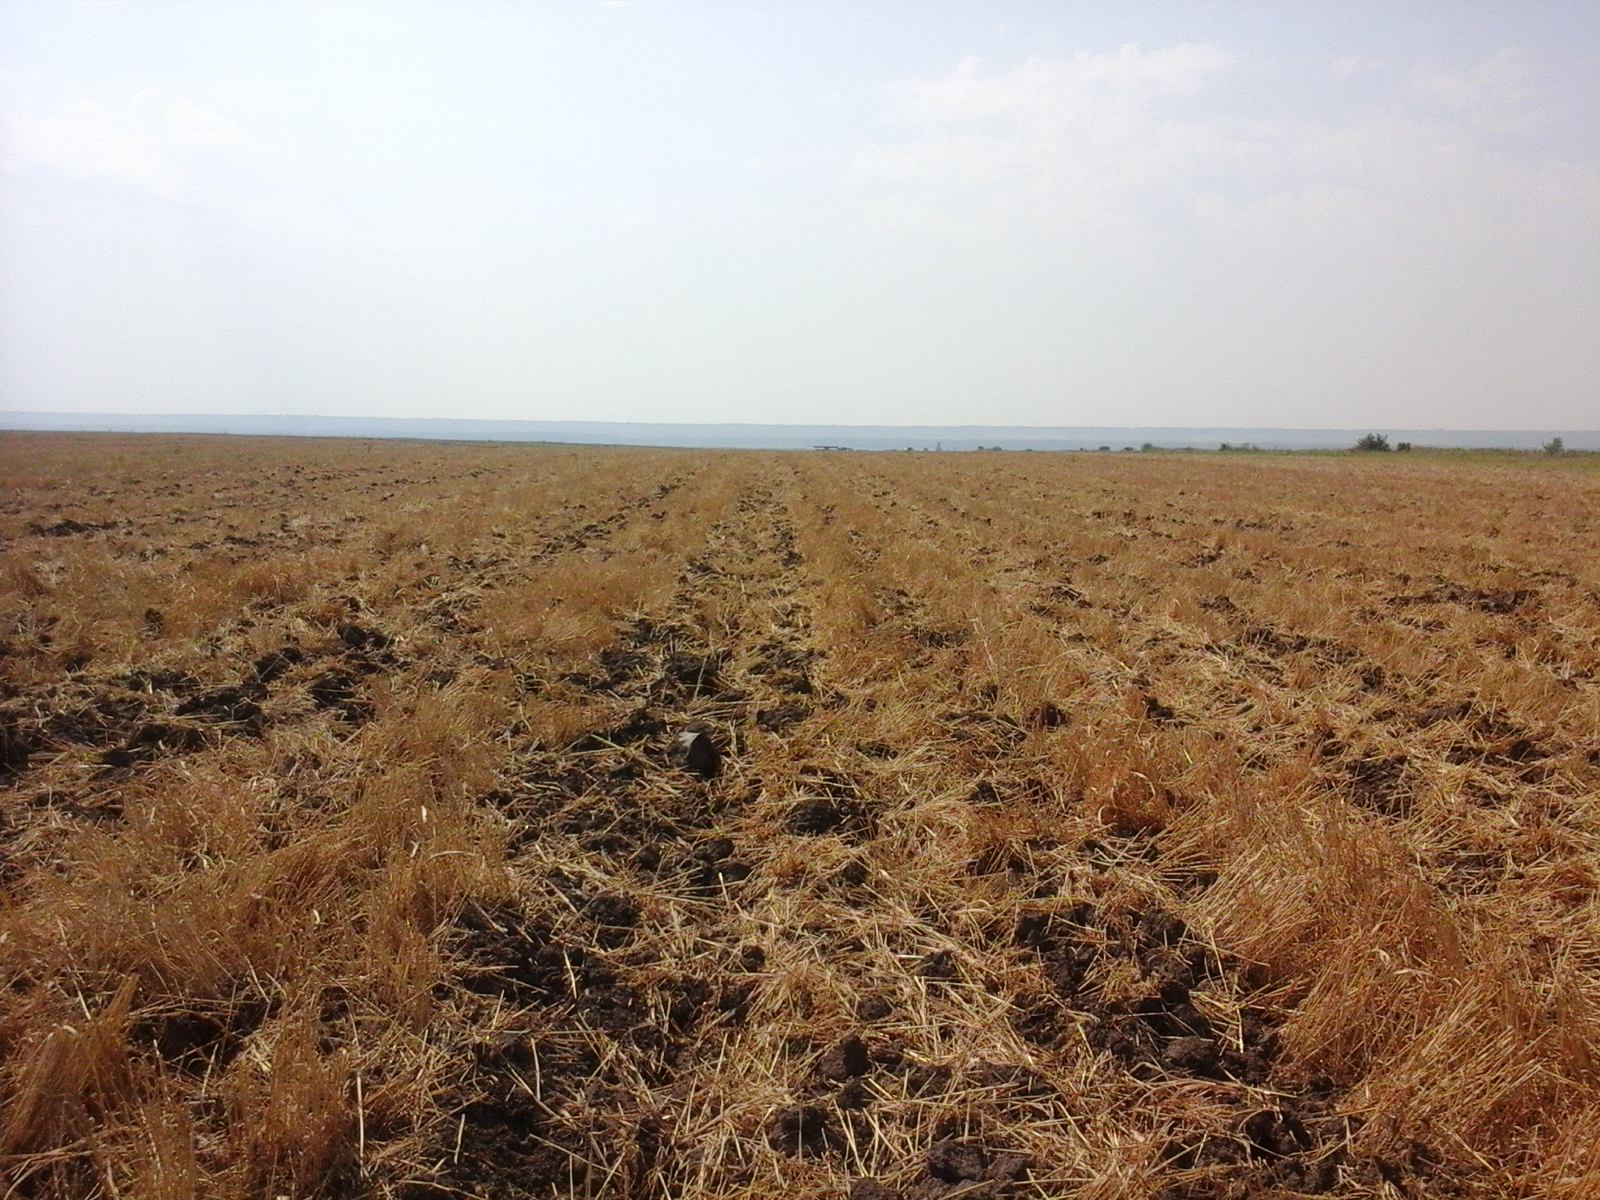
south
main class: Cropland
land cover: Common wheat
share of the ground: 50 - 75 %
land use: Agriculture (excluding fallow land and kitchen gardens)
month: August
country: RO
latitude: 43.9060
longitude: 23.3311
